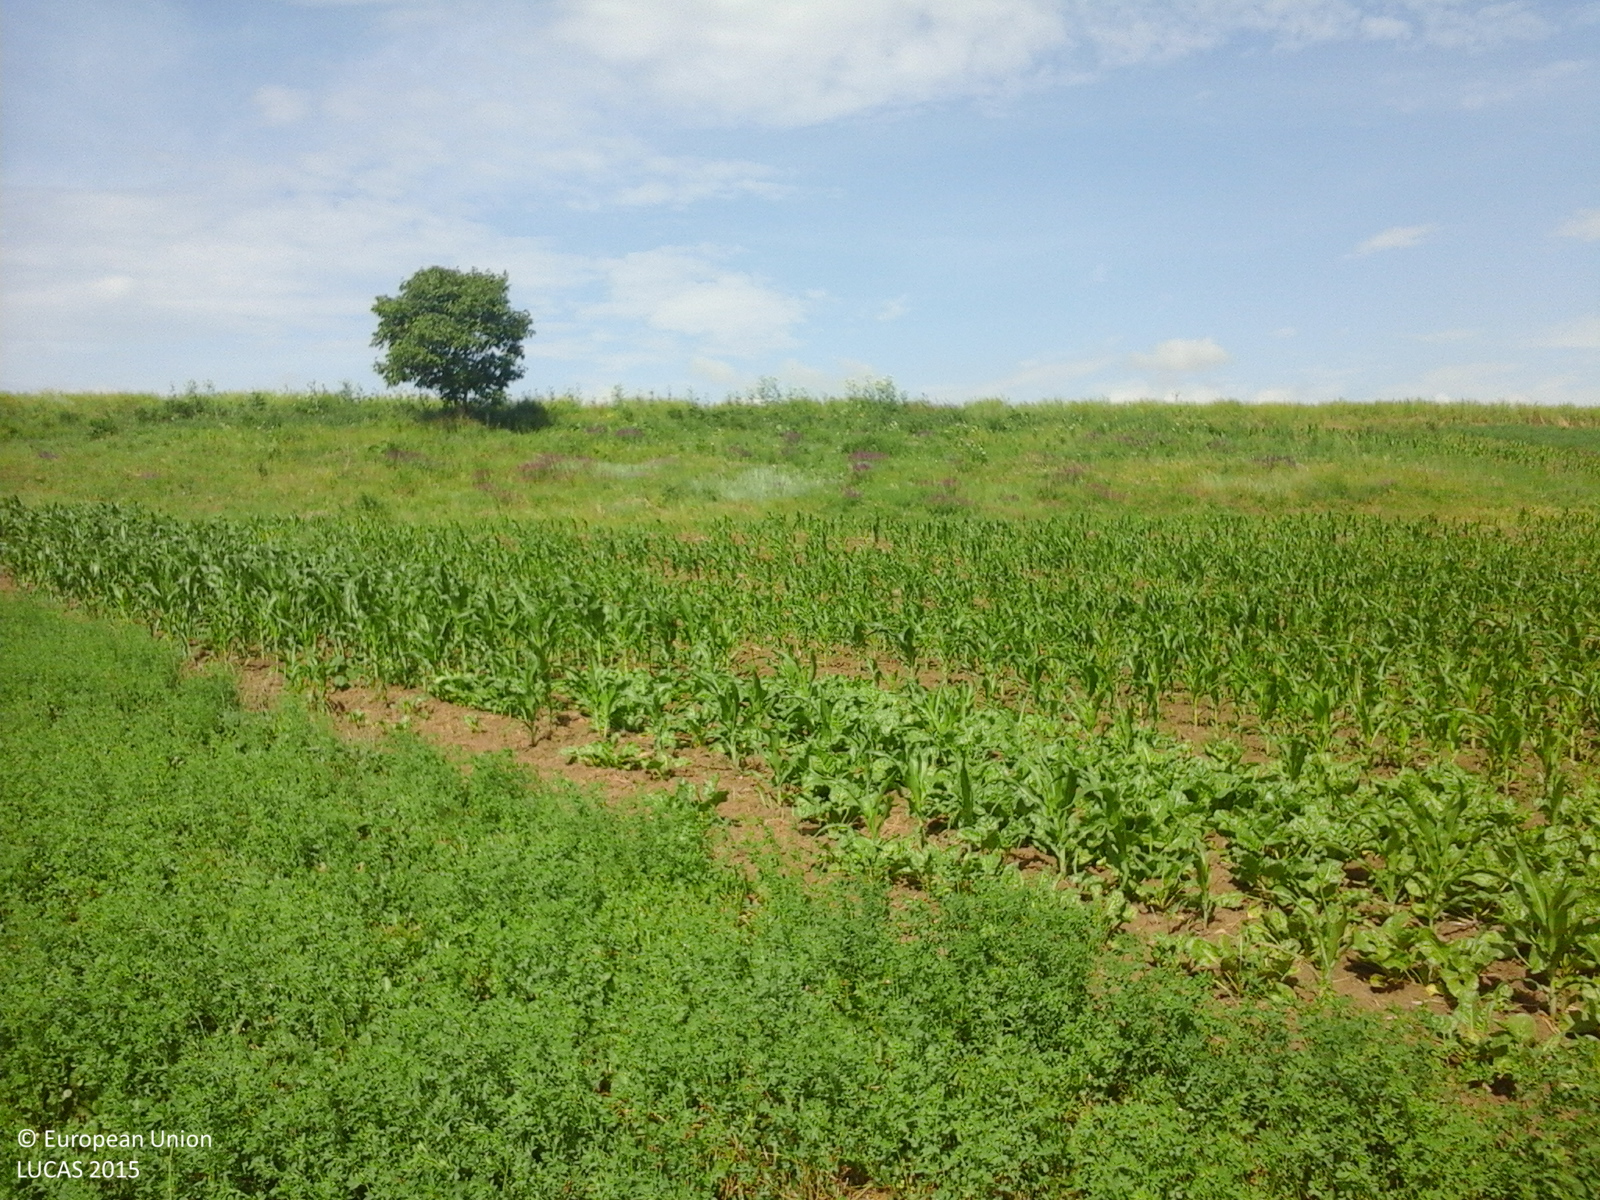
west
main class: Cropland
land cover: Lucerne
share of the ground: > 75 %
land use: Agriculture (excluding fallow land and kitchen gardens)
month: June
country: RO
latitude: 47.1247
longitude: 26.7960
